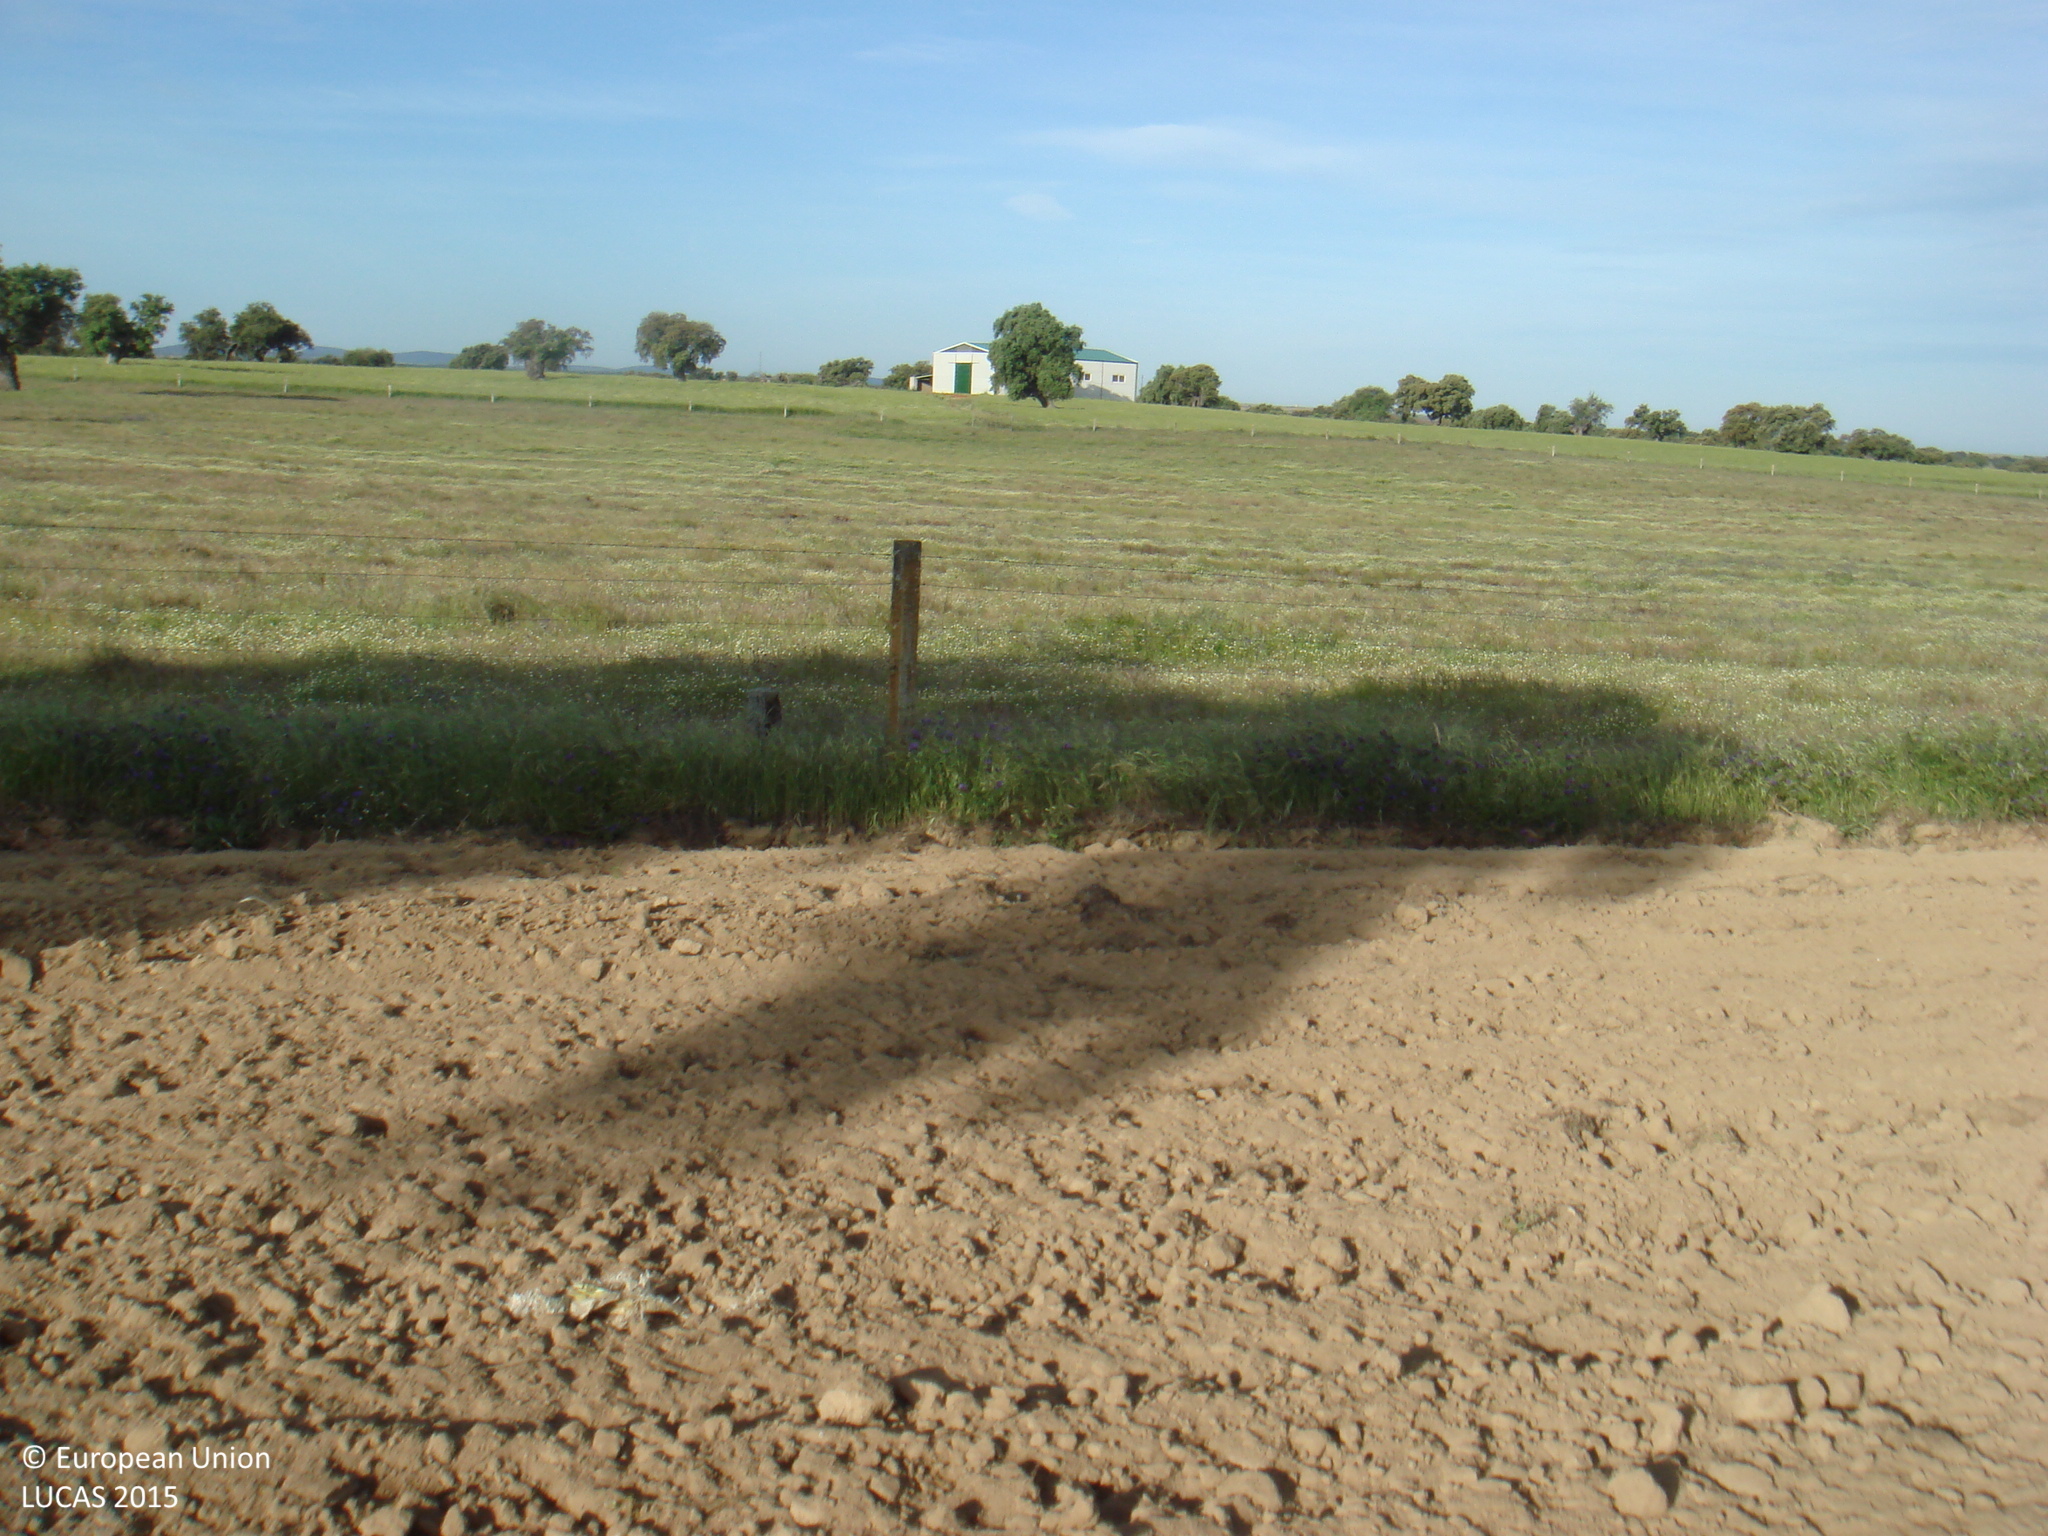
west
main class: Woodland
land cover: Broadleaved woodland
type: broadleaved evergreen forest
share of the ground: 25 - 50 %
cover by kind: herbaceous plants 60 %, broadleaved forest trees 40 %
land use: Agriculture (excluding fallow land and kitchen gardens)
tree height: > 5 m
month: May
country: ES
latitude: 38.4698
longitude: -5.0773
